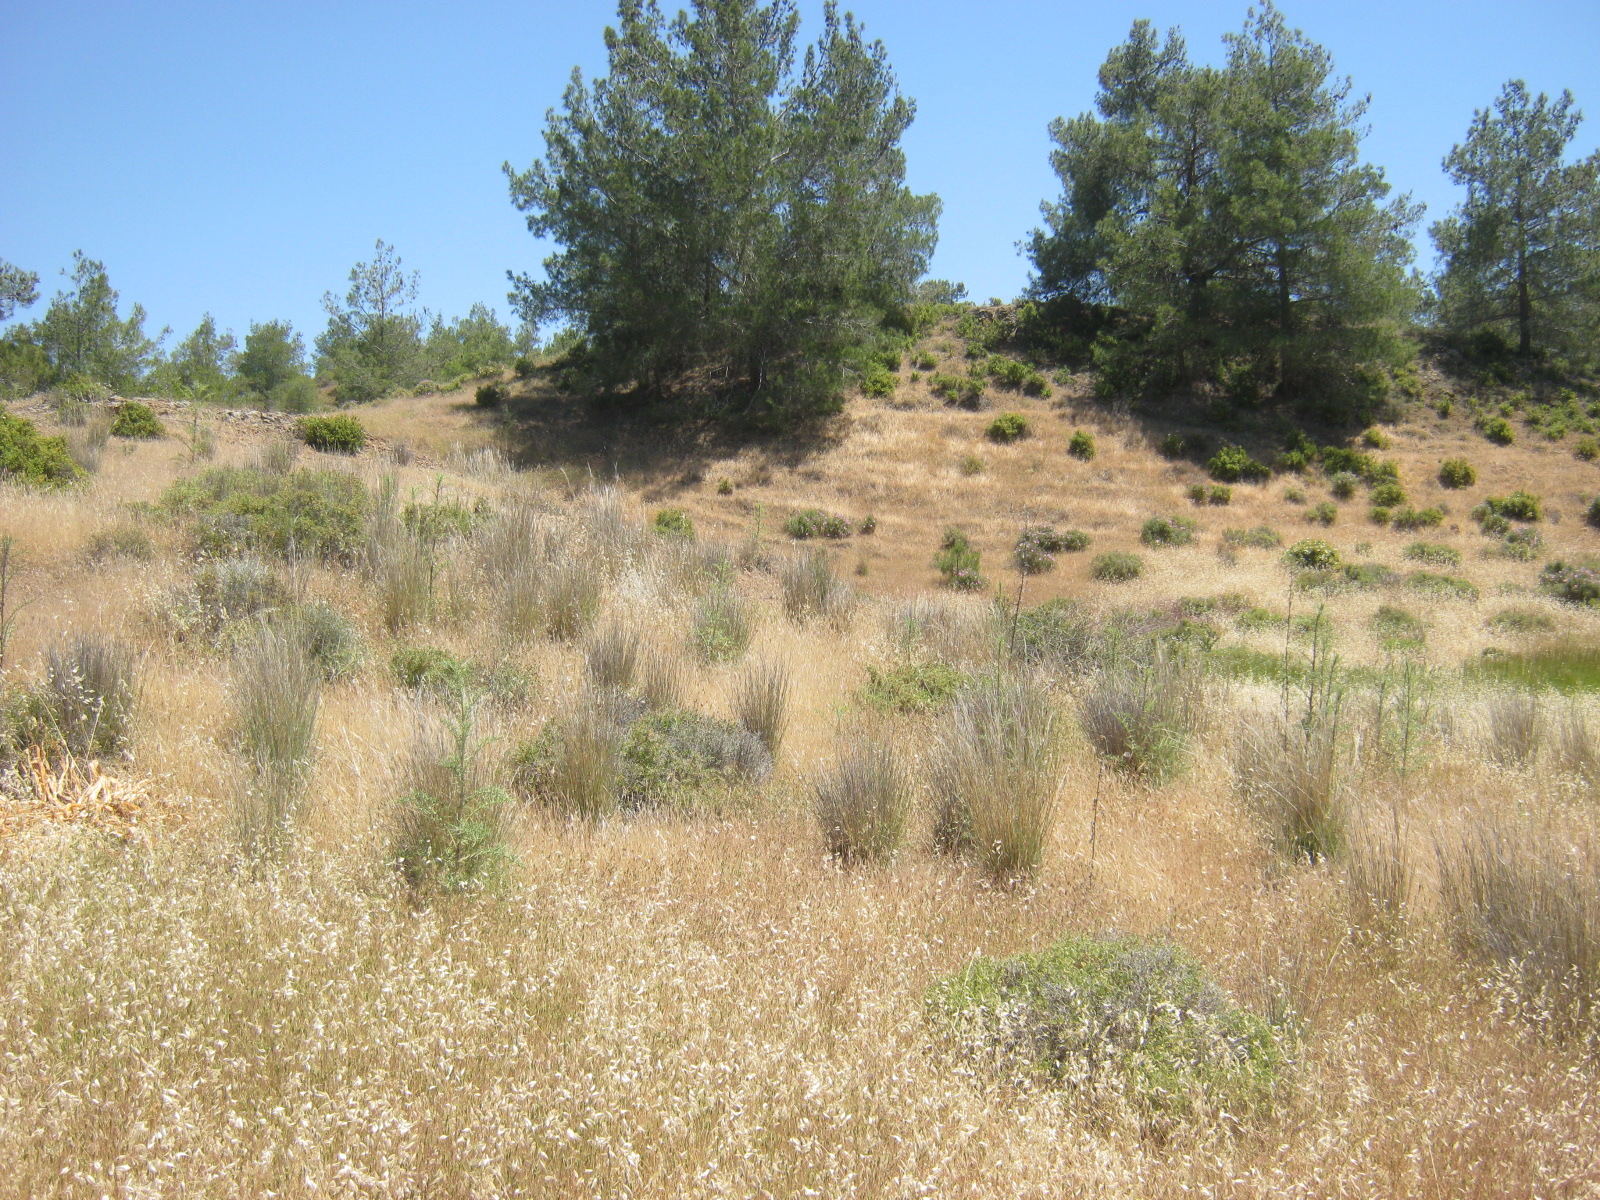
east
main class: Grassland
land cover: Grassland with sparse tree/shrub cover
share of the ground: > 75 %
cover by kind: herbaceous plants 80 %, unconsolidated bare surface 10 %, coniferous forest trees 5 %, shrubs 5 %
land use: Semi-natural and natural areas not in use
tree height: > 5 m
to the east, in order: Grassland with sparse tree/shrub cover; Pine dominated coniferous woodland; Tracks; Pine dominated coniferous woodland; Tracks; Pine dominated coniferous woodland; Other bare soil
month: May
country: CY
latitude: 35.0044
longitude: 33.2034
